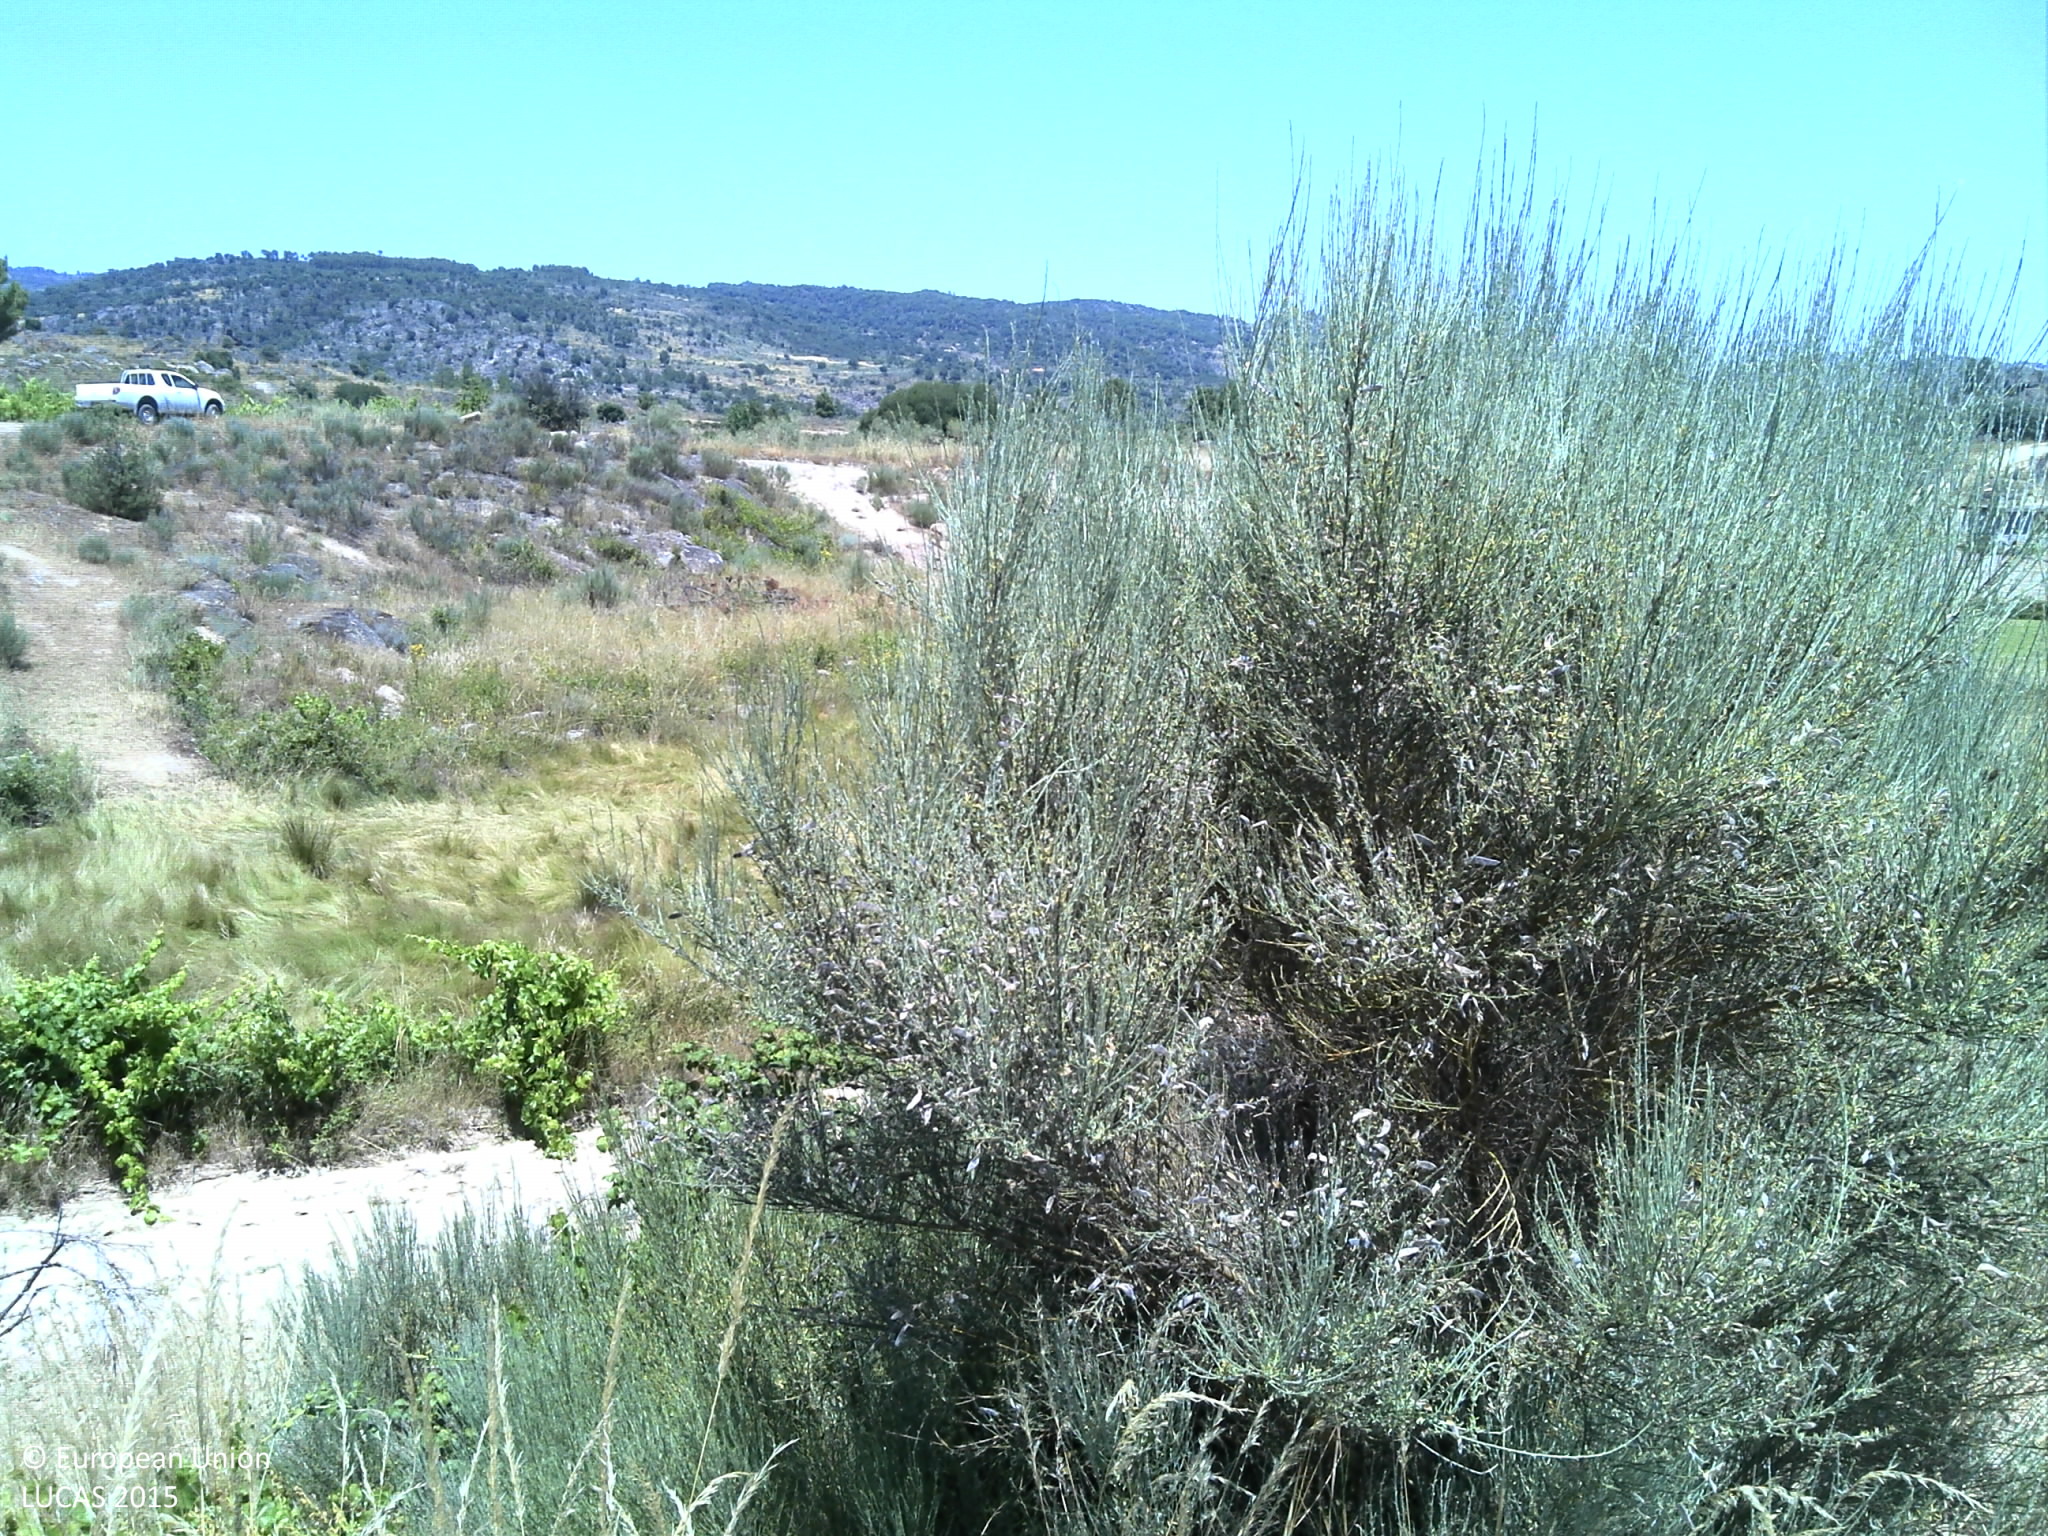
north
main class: Cropland
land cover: Vineyards
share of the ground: 10 - 25 %
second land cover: Grassland without tree/shrub cover
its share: 10 - 25 %
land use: Agriculture (excluding fallow land and kitchen gardens)
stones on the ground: > 50 %
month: June
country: PT
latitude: 40.8826
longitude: -7.2598
